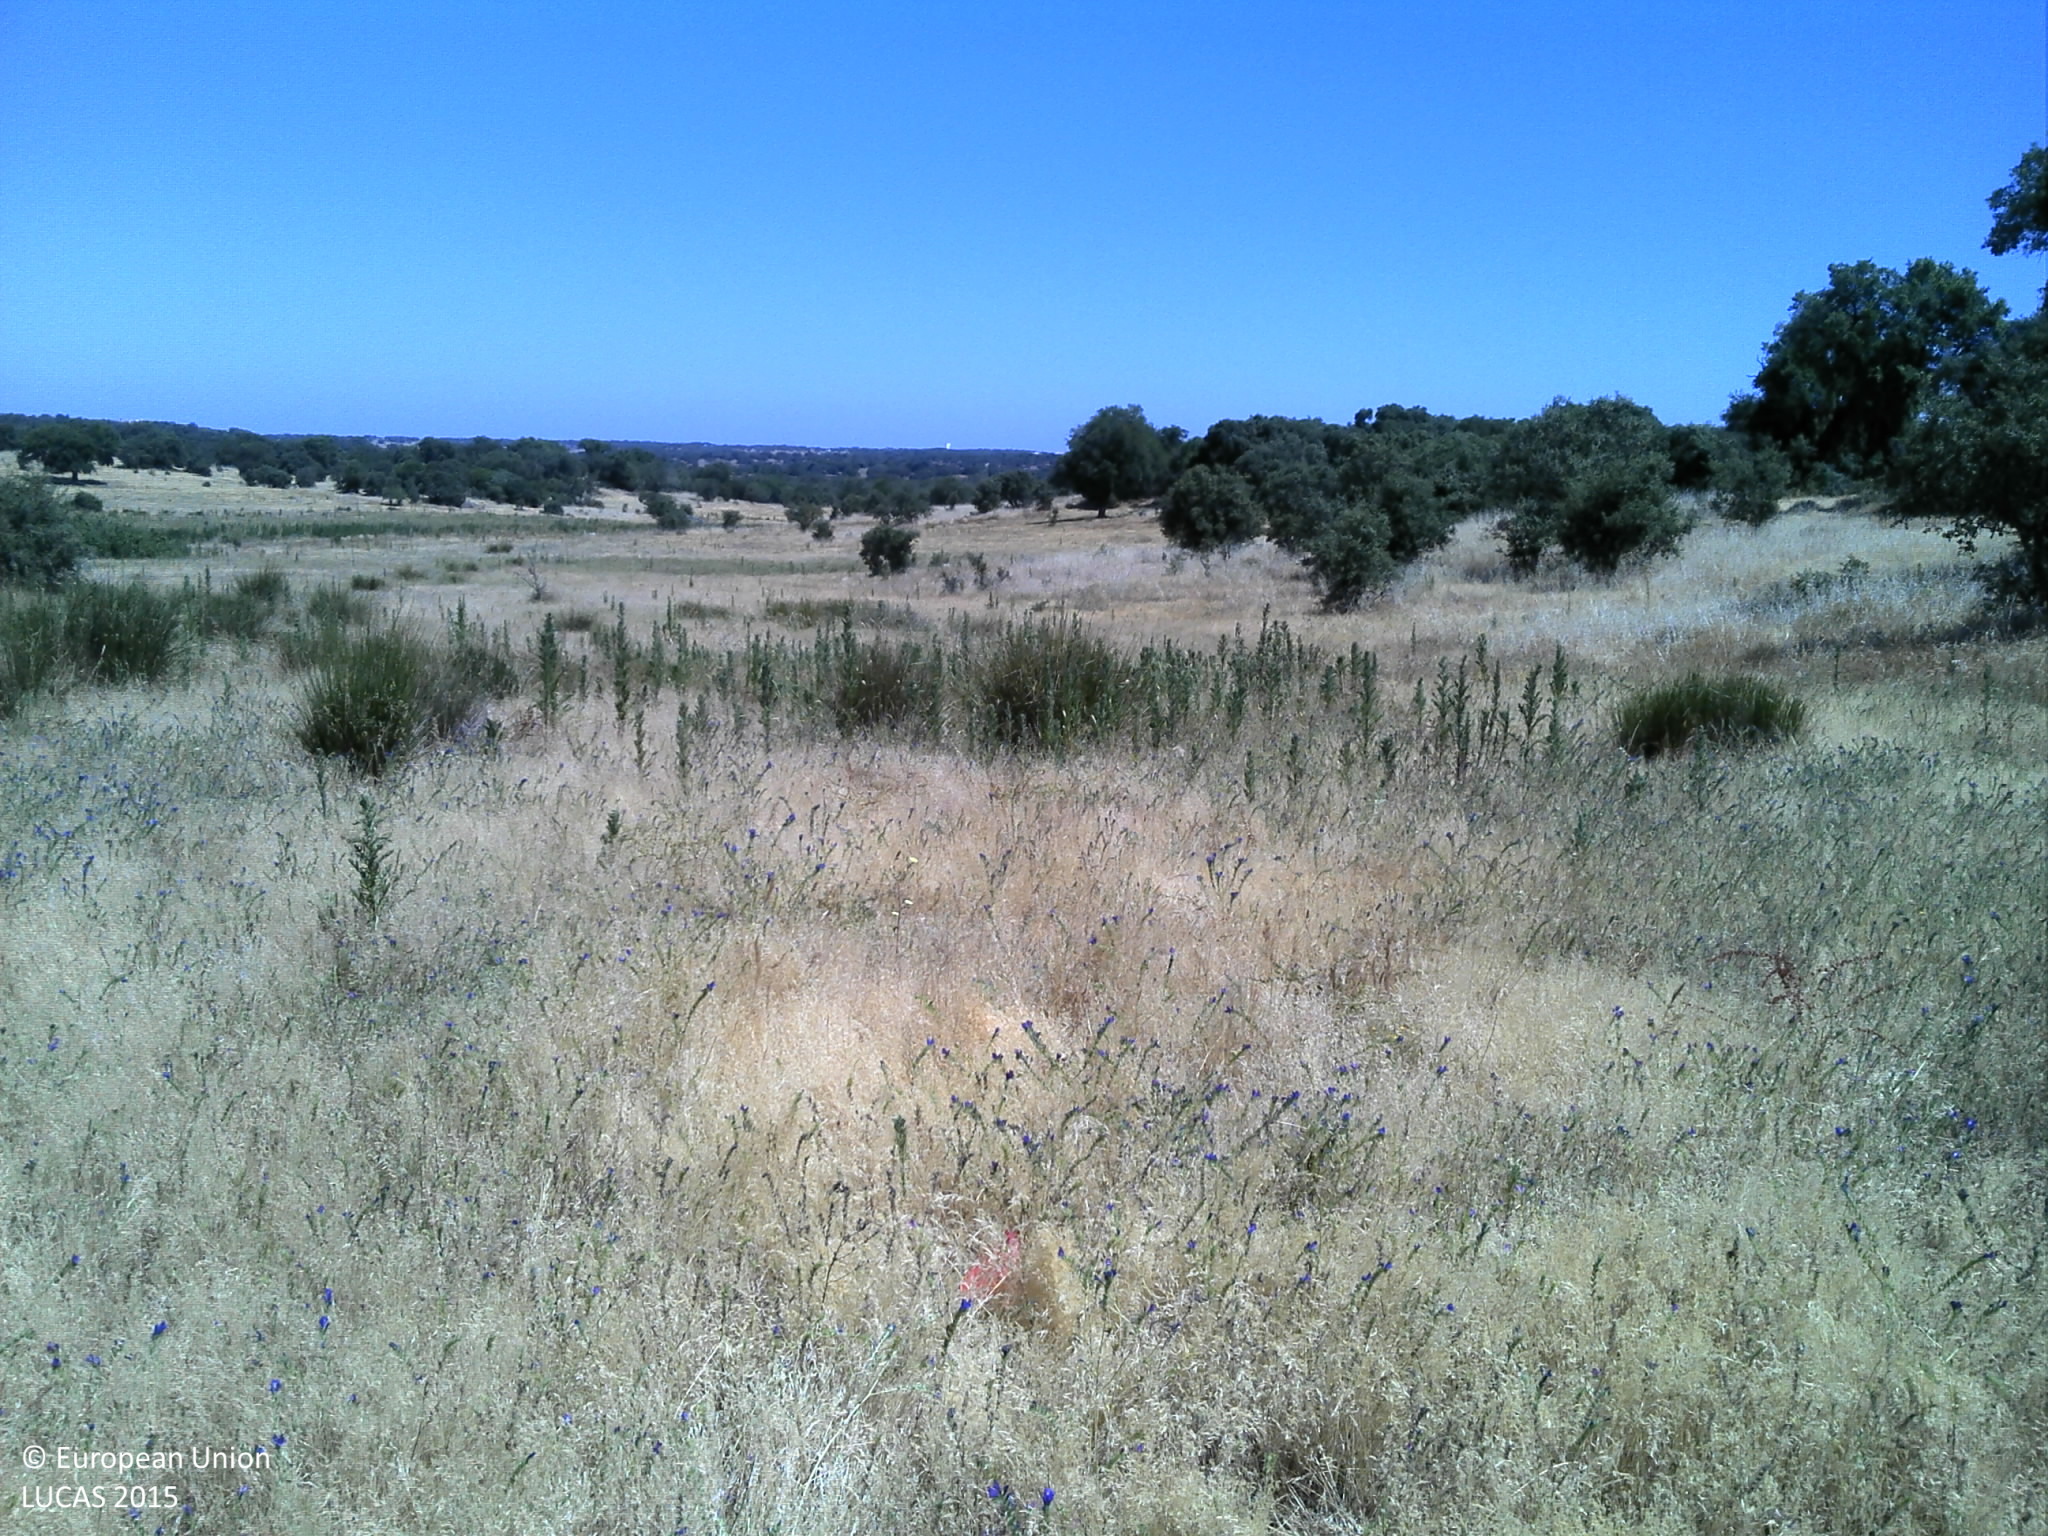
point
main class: Grassland
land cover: Grassland with sparse tree/shrub cover
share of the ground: 25 - 50 %
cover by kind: herbaceous plants 90 %, broadleaved forest trees 5 %, unconsolidated bare surface 5 %
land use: Agriculture (excluding fallow land and kitchen gardens)
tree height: < 5 m
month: June
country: PT
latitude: 38.7353
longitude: -8.1914
